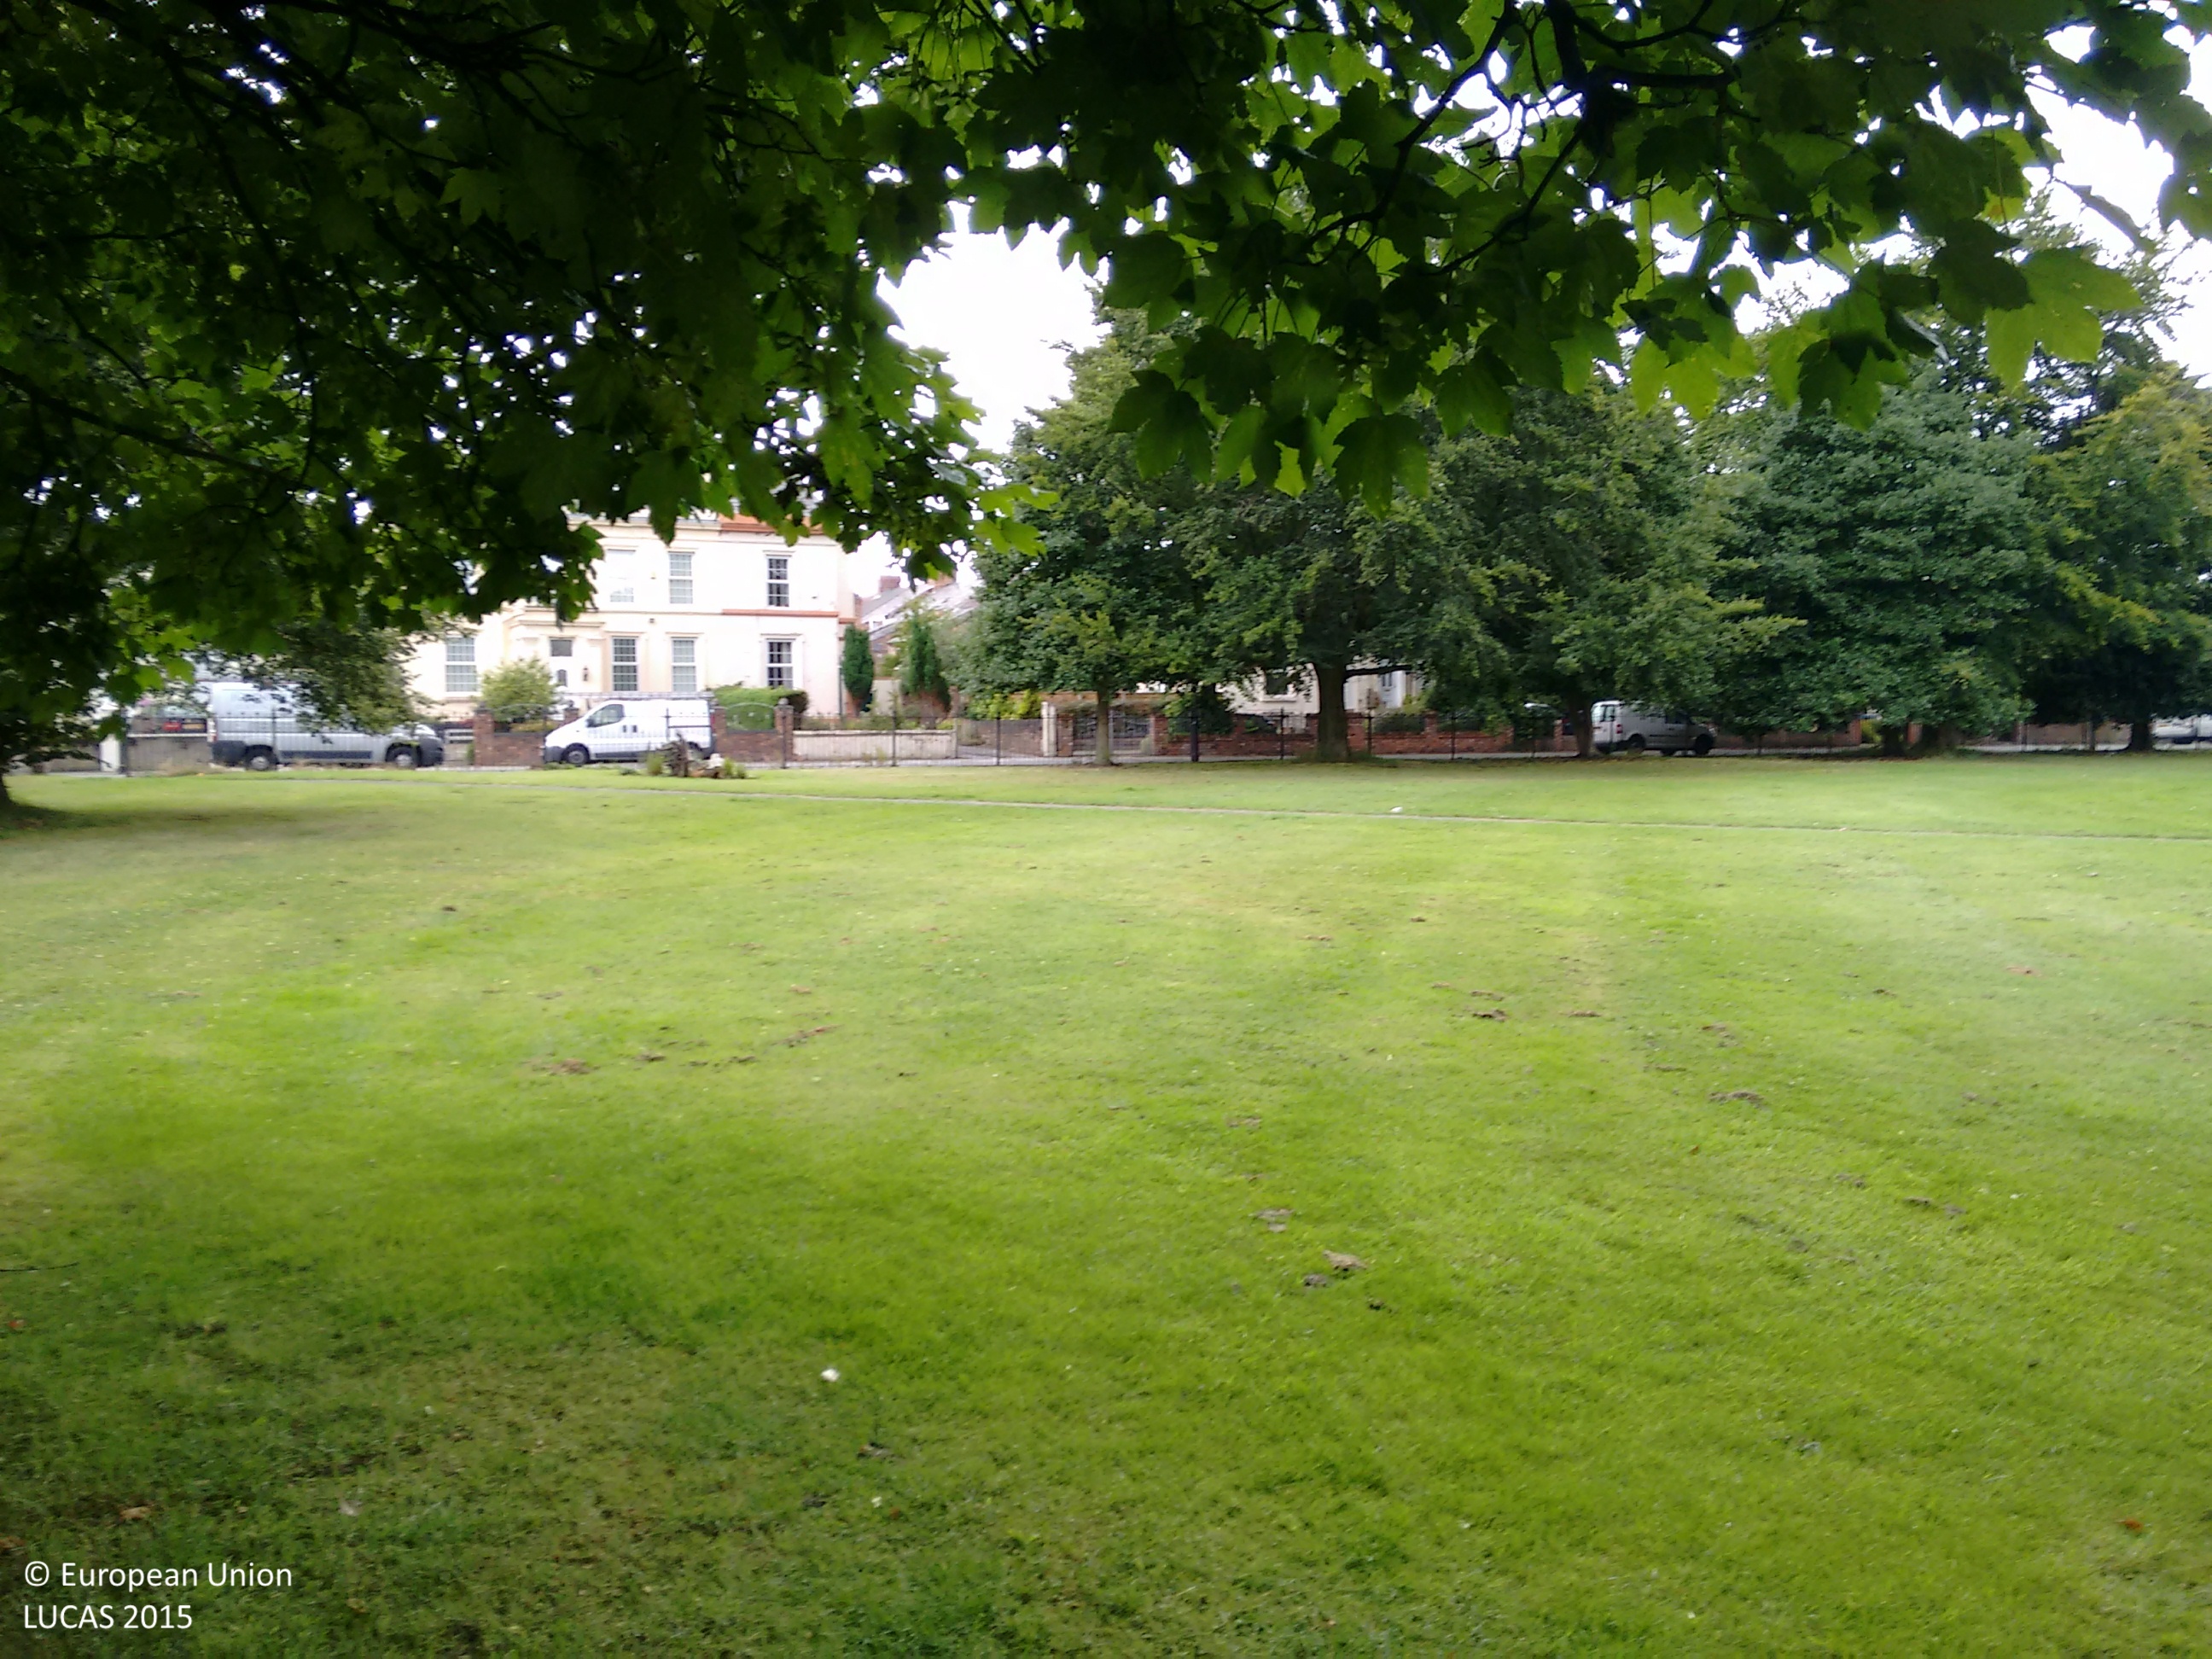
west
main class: Grassland
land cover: Grassland with sparse tree/shrub cover
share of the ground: > 75 %
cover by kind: herbaceous plants 95 %, broadleaved forest trees 5 %
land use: Amenities, museums, leisure
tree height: > 5 m
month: July
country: GB
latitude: 53.4148
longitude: -2.9369
